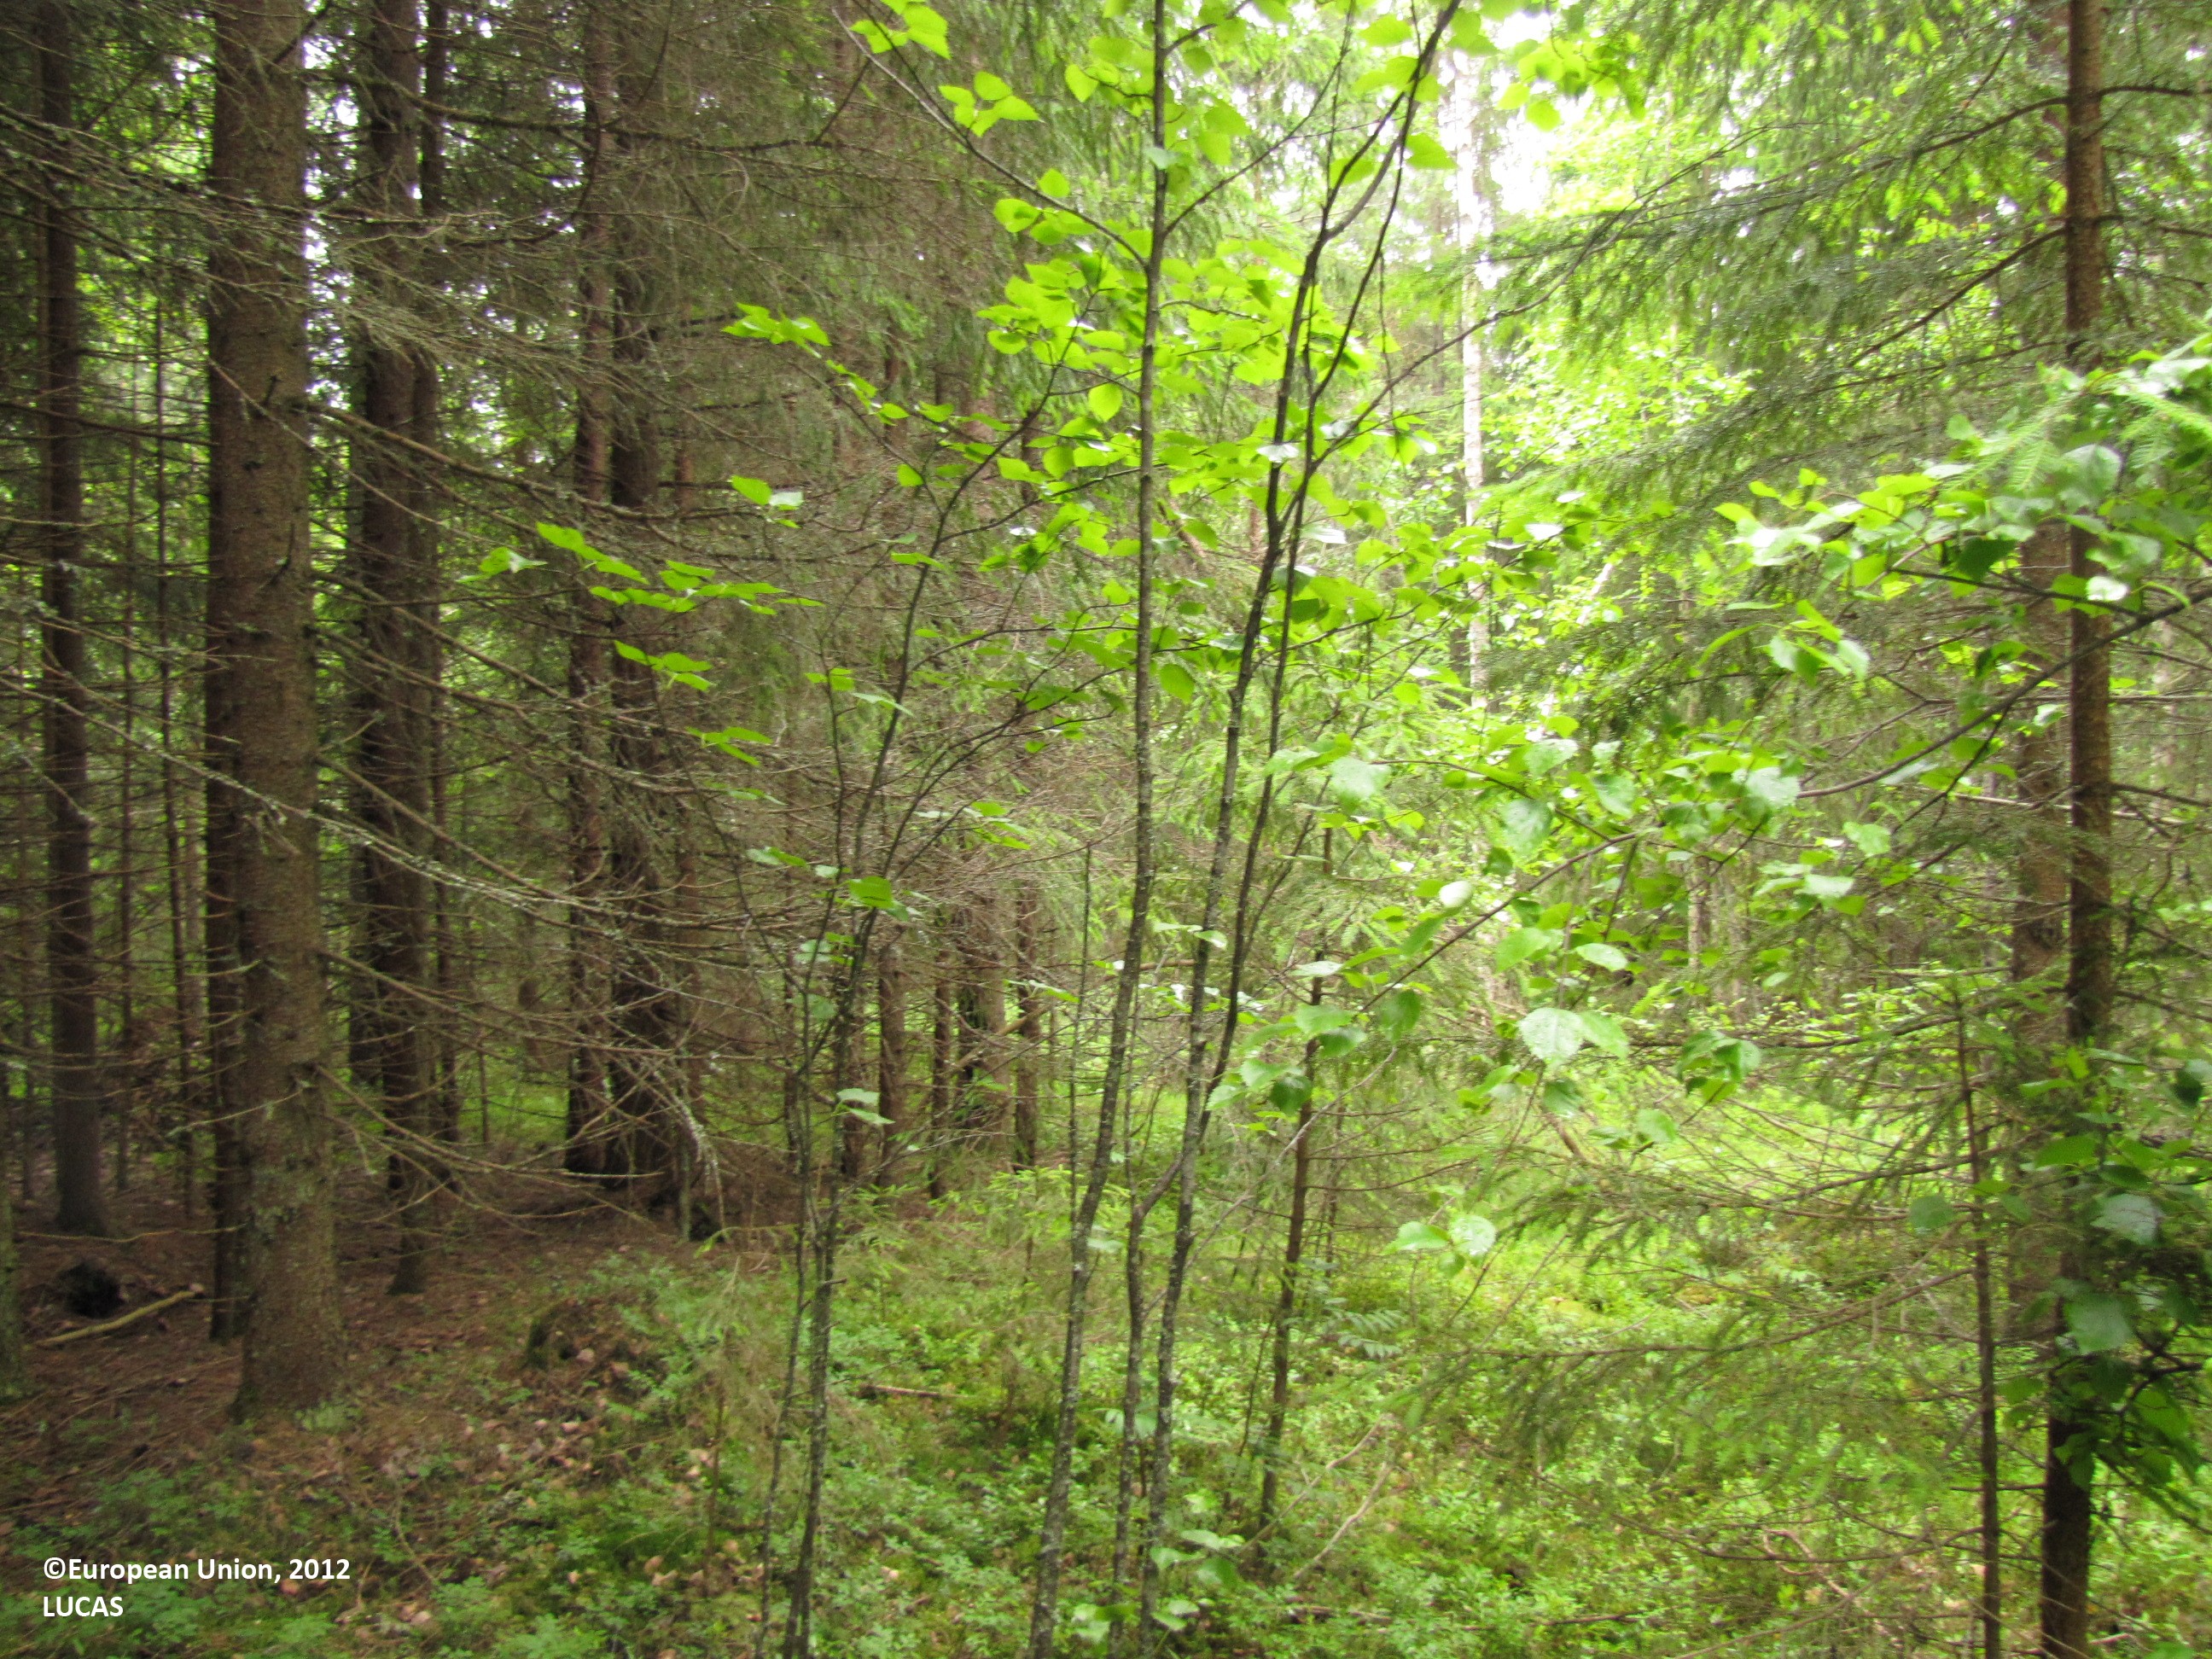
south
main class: Woodland
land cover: Spruce dominated coniferous woodland
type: boreal forest
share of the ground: > 75 %
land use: Forestry
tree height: > 5 m
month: June
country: FI
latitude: 61.7707
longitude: 24.5575
